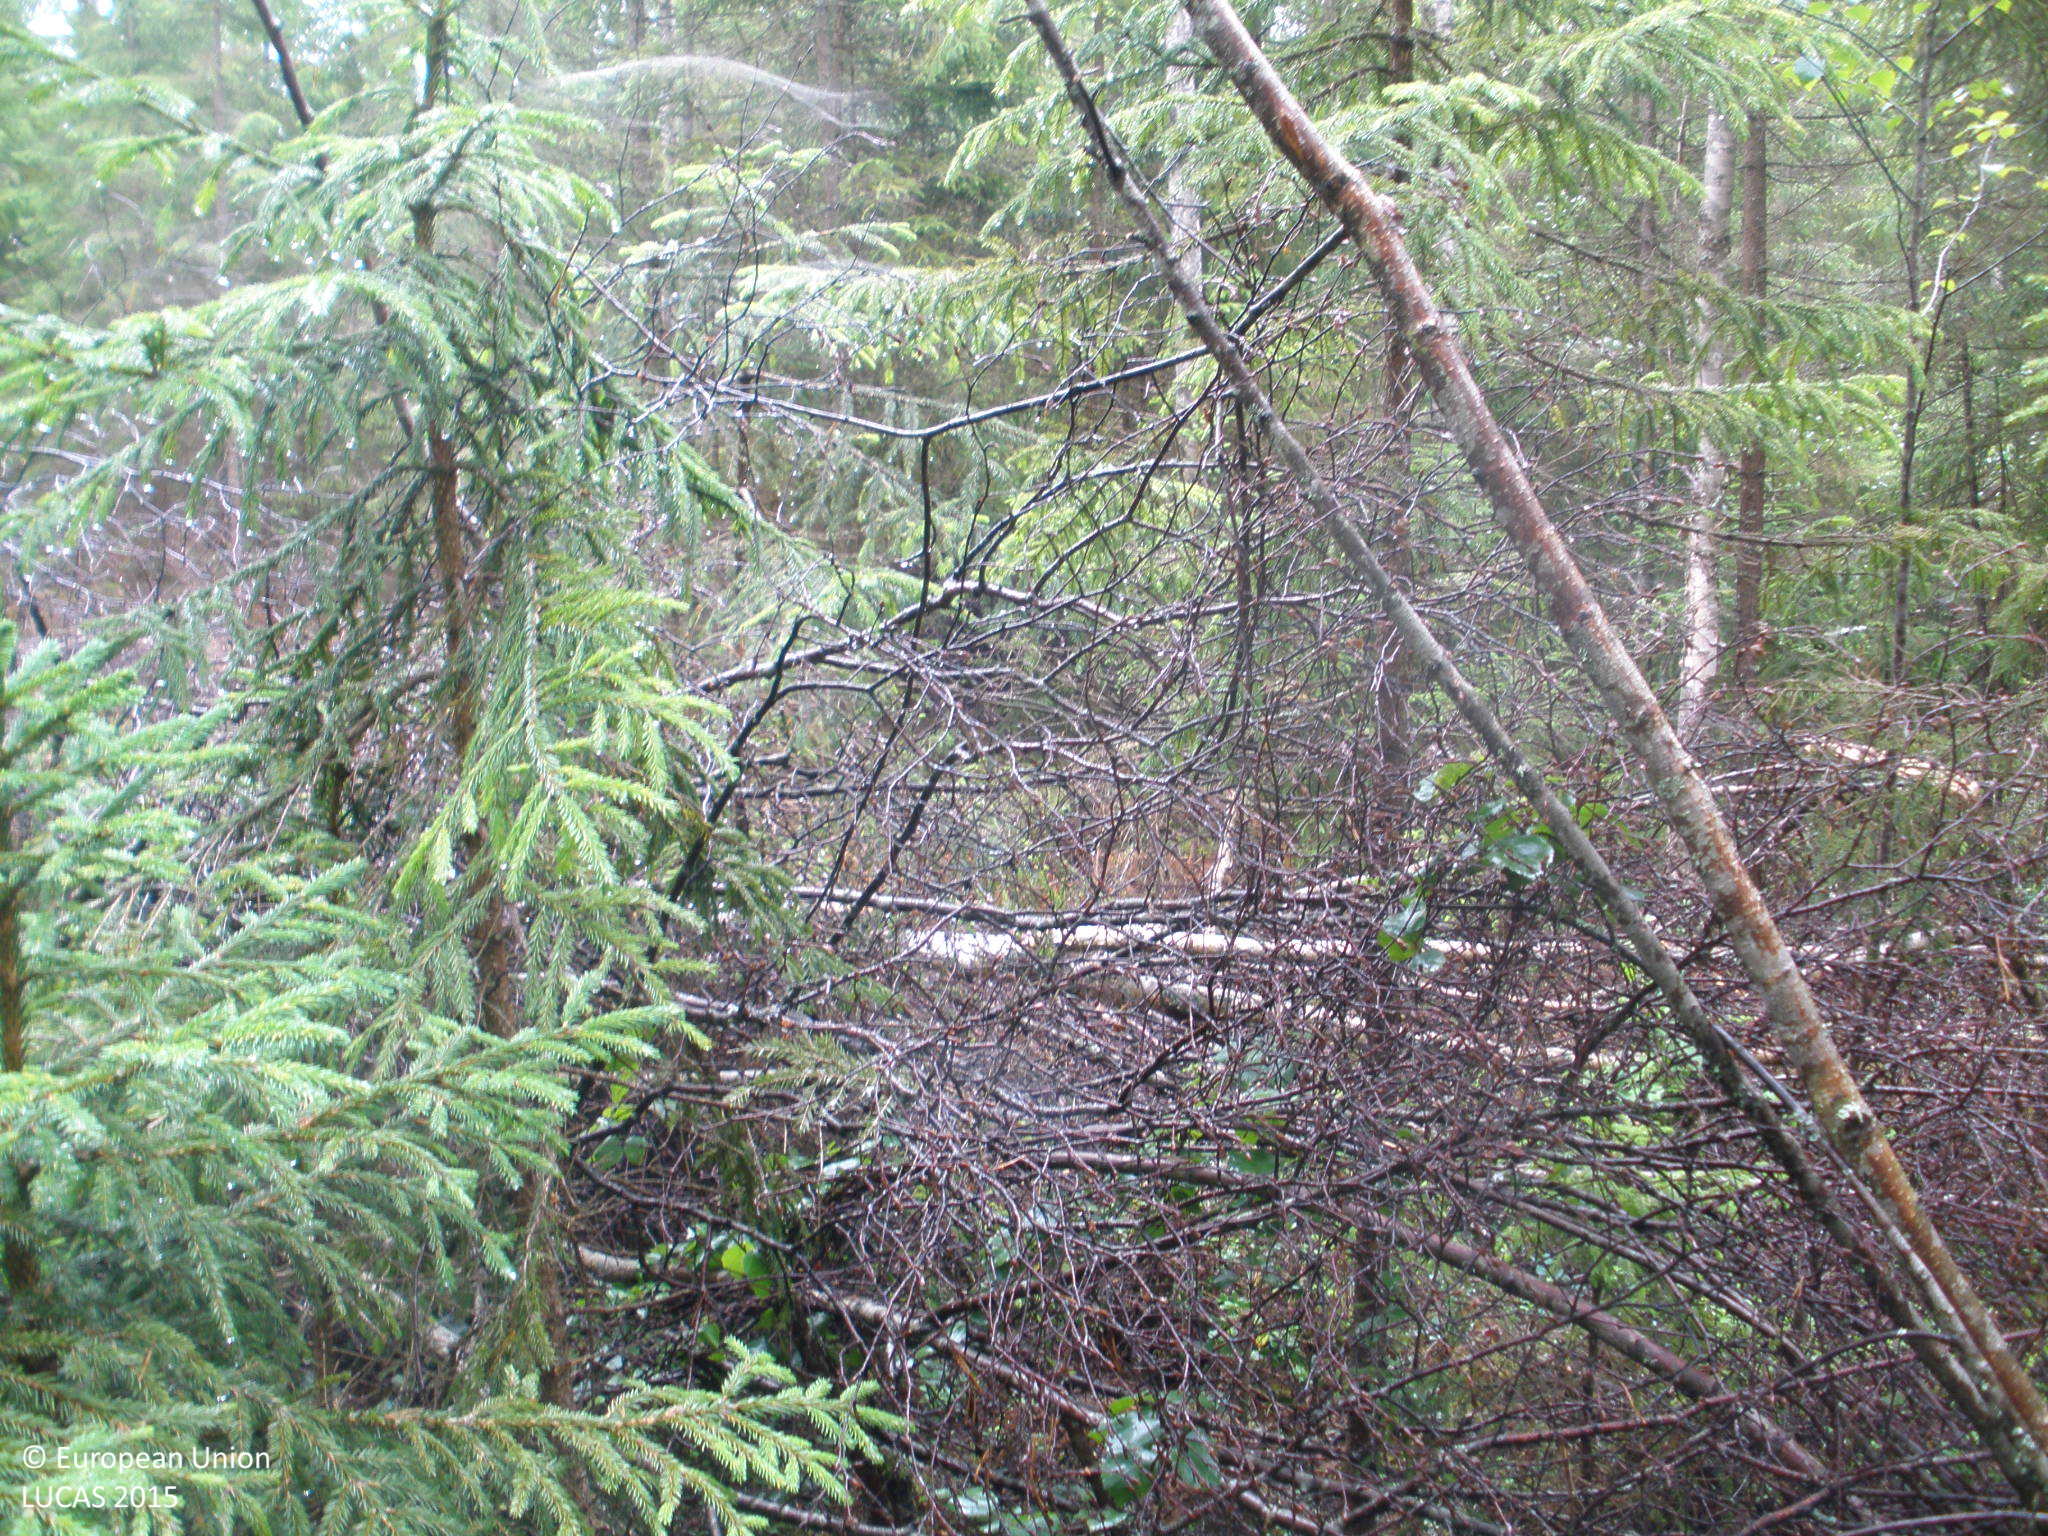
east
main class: Woodland
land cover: Pine dominated mixed woodland
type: boreal forest
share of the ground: > 75 %
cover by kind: coniferous forest trees 60 %, broadleaved forest trees 25 %, lichens and mosses 10 %, shrubs 5 %
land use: Forestry
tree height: > 5 m
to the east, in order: Pine dominated mixed woodland; Tracks; Spruce dominated mixed woodland; Spruce dominated coniferous woodland; Ditches and canals; Spruce dominated coniferous woodland; Tracks; Ditches and canals; Spruce dominated mixed woodland; Ditches and canals; Other mixed woodland; Broadleaved woodland; Pine dominated coniferous woodland
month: July
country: FI
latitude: 61.0290
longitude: 24.9744
